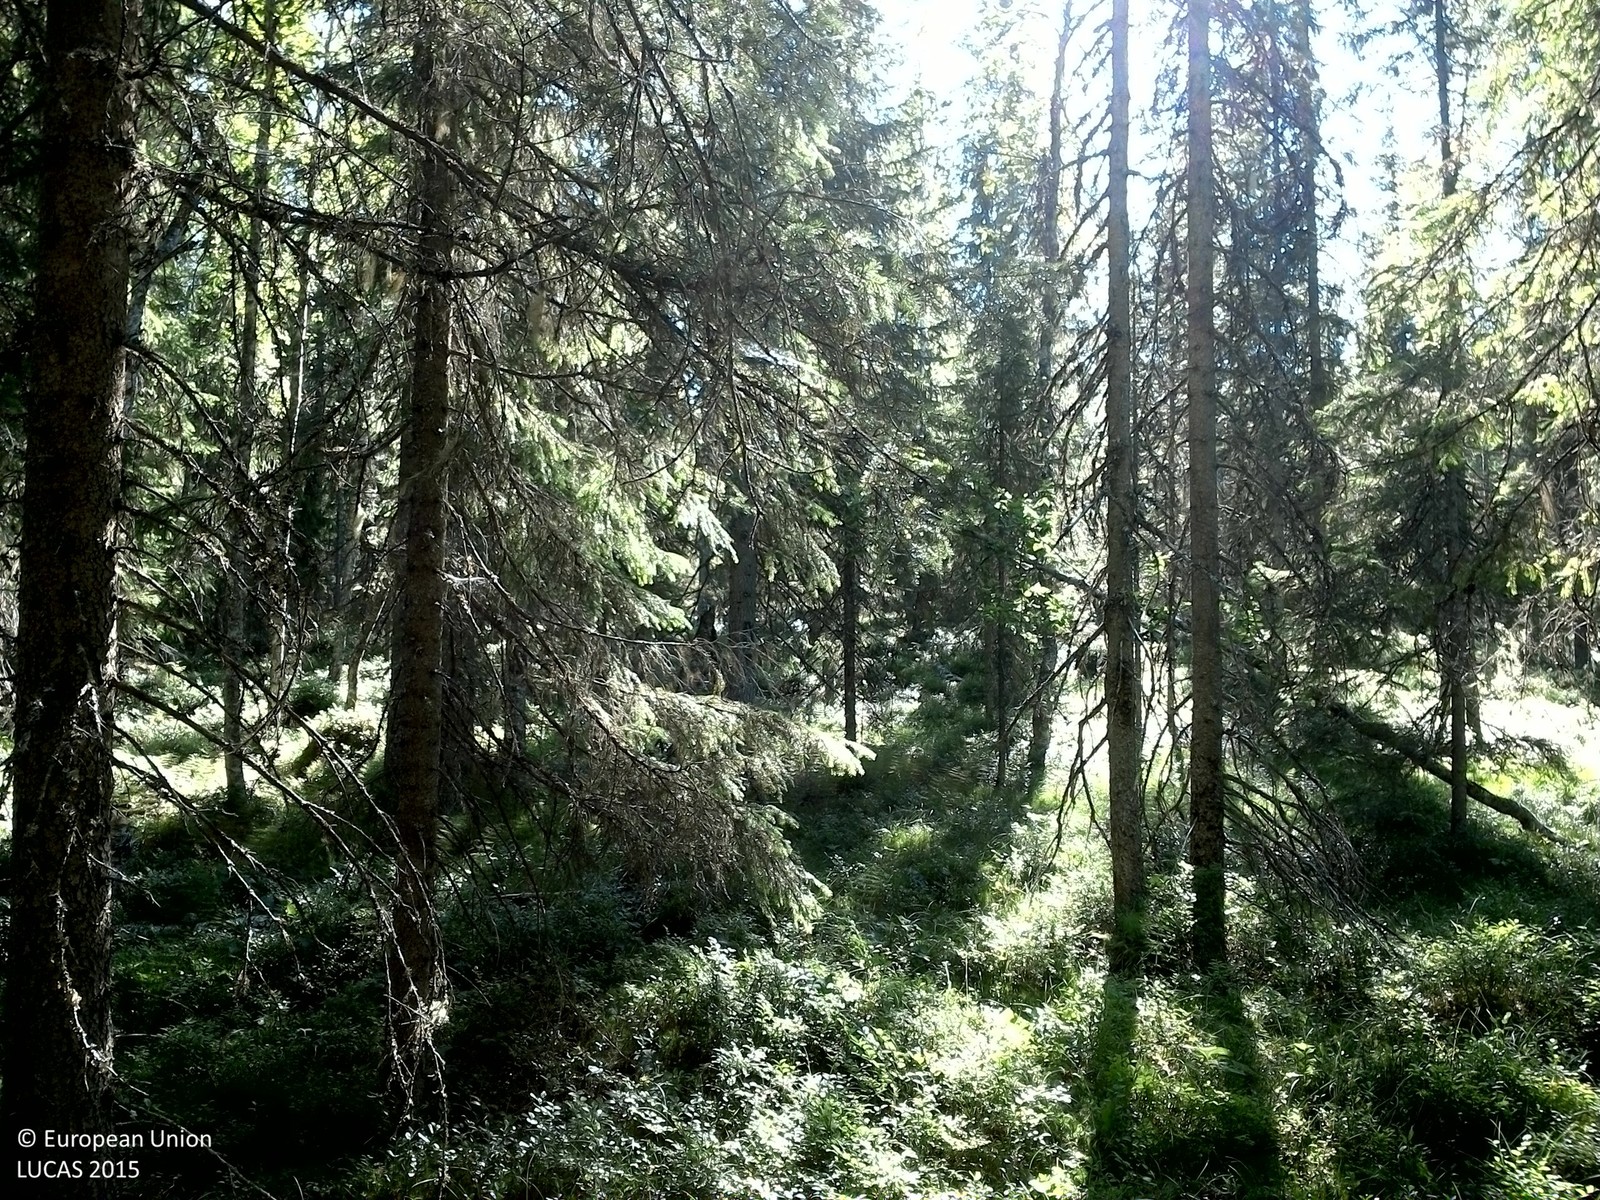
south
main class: Woodland
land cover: Spruce dominated coniferous woodland
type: boreal forest
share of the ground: > 75 %
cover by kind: coniferous forest trees 75 %, shrubs 15 %, broadleaved forest trees 5 %, lichens and mosses 5 %
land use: Forestry
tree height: > 5 m
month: August
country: SE
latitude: 63.7212
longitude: 17.3211
